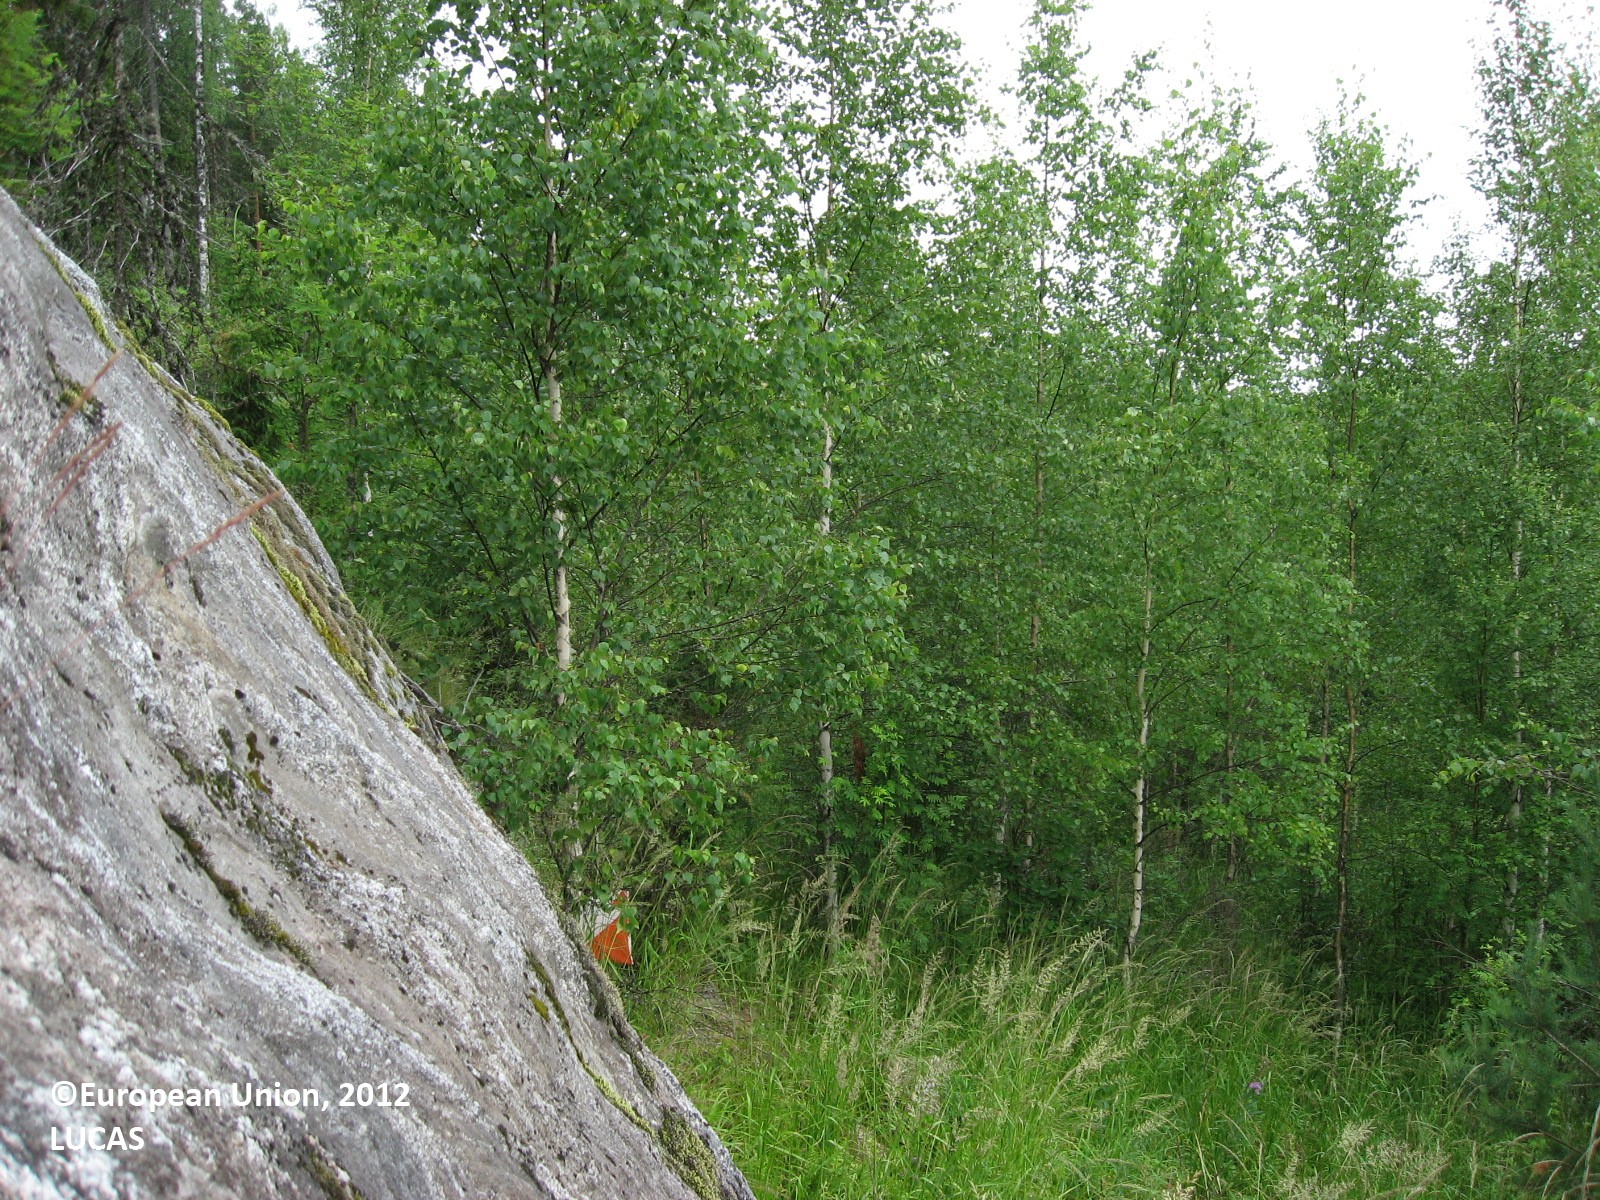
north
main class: Woodland
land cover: Pine dominated mixed woodland
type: boreal forest
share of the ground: > 75 %
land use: Forestry
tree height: > 5 m
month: July
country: FI
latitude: 60.8369
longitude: 25.5631
